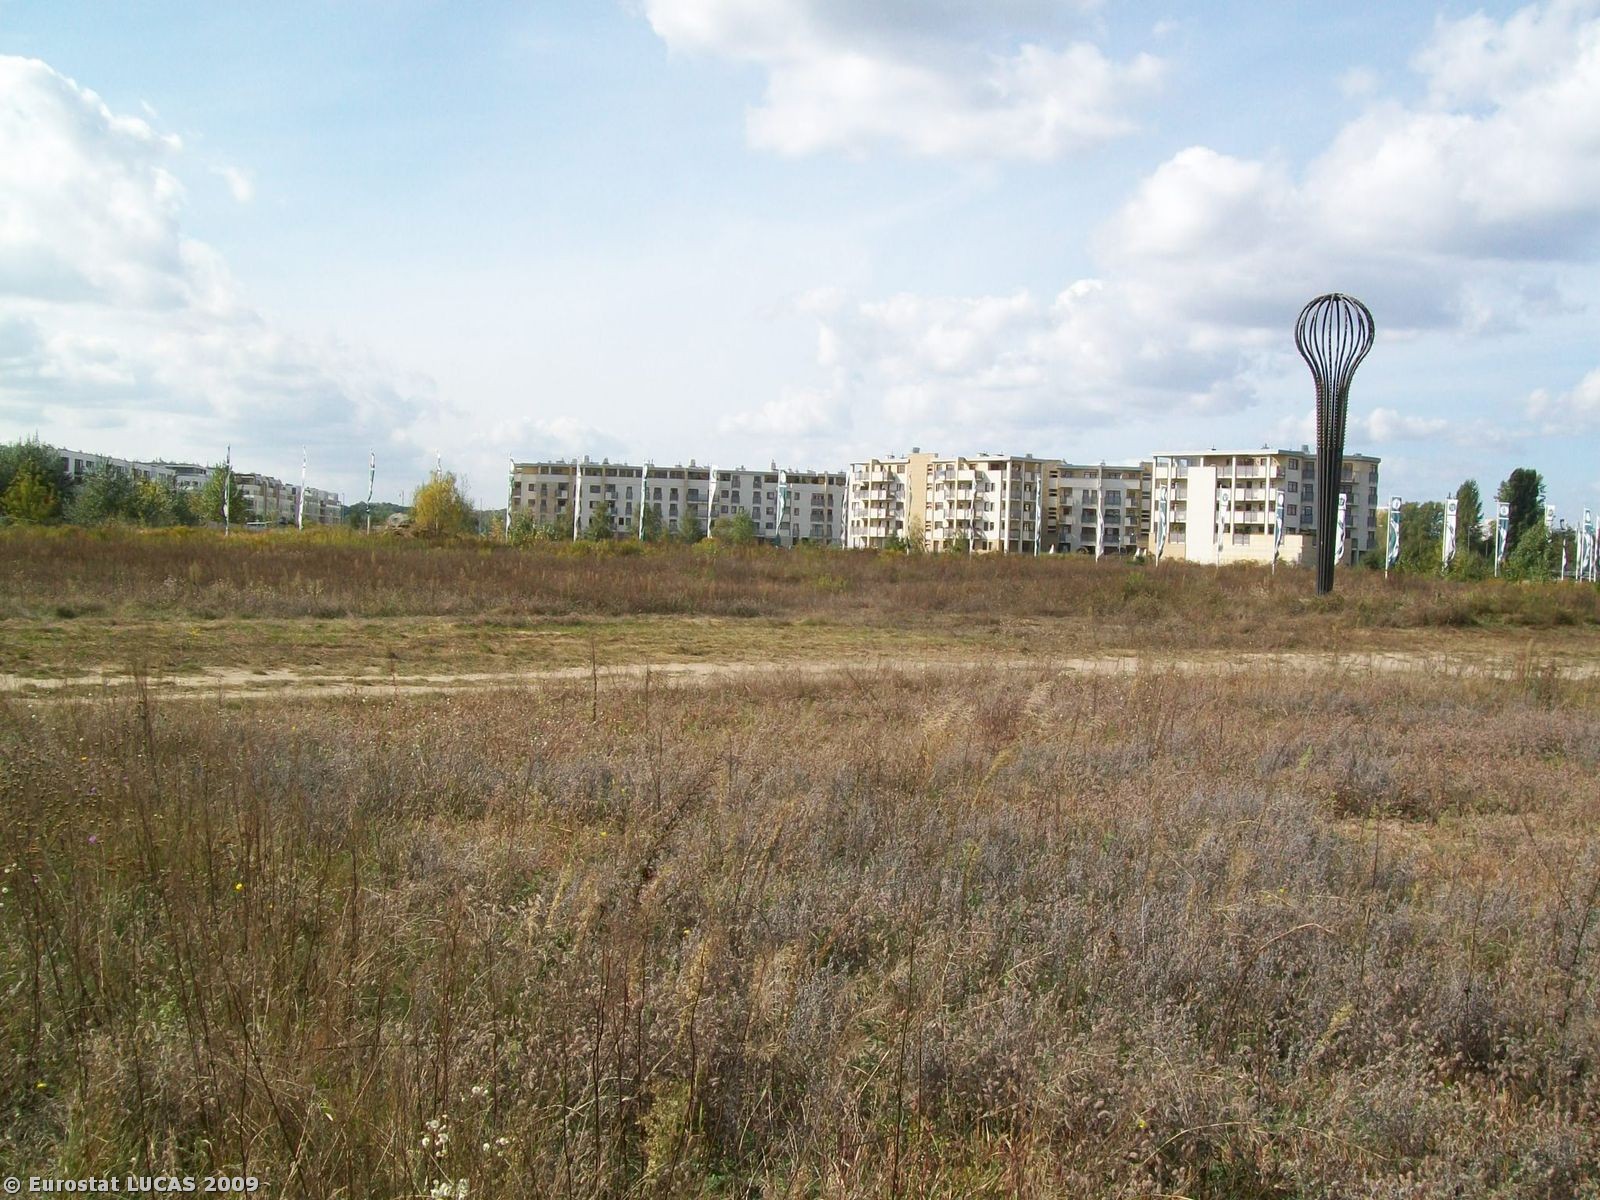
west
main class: Grassland
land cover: Grassland without tree/shrub cover
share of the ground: > 75 %
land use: Unused
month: September
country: PL
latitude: 52.1653
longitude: 21.0834
